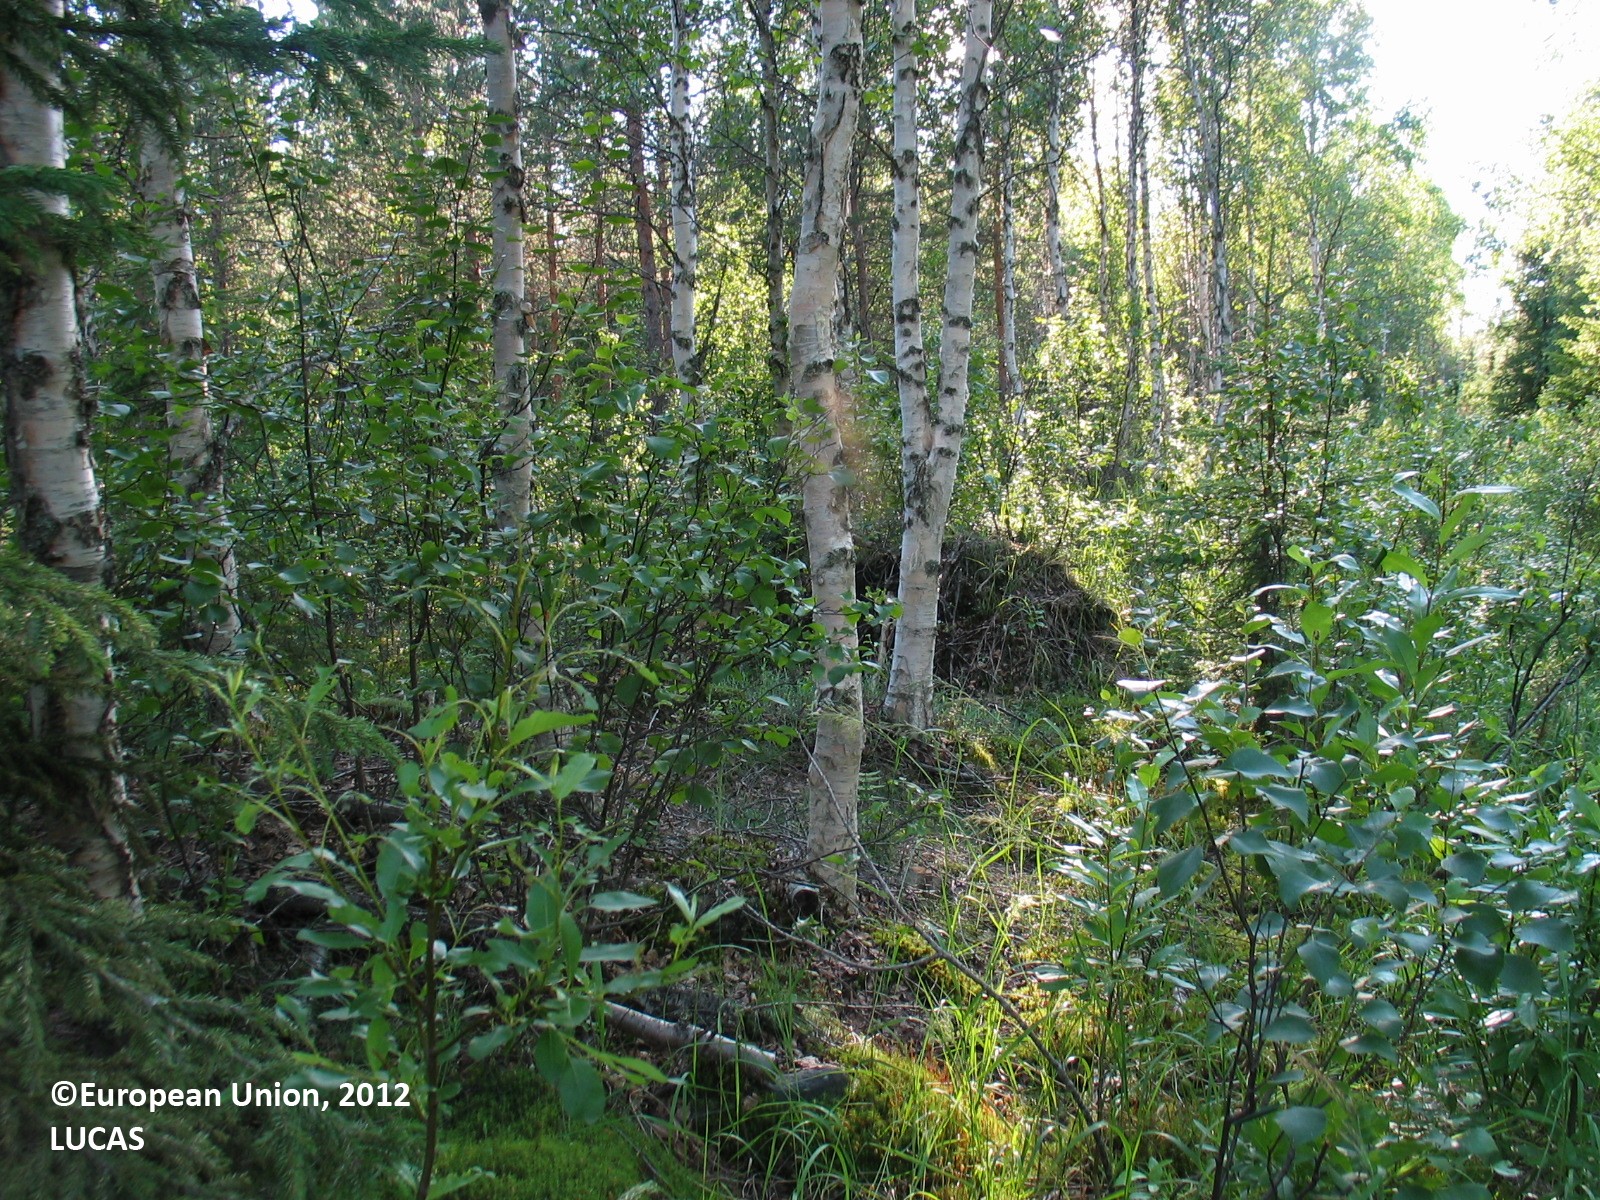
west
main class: Woodland
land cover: Broadleaved woodland
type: boreal forest
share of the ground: 25 - 50 %
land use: Forestry
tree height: > 5 m
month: July
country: FI
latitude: 65.7983
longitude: 24.8602
